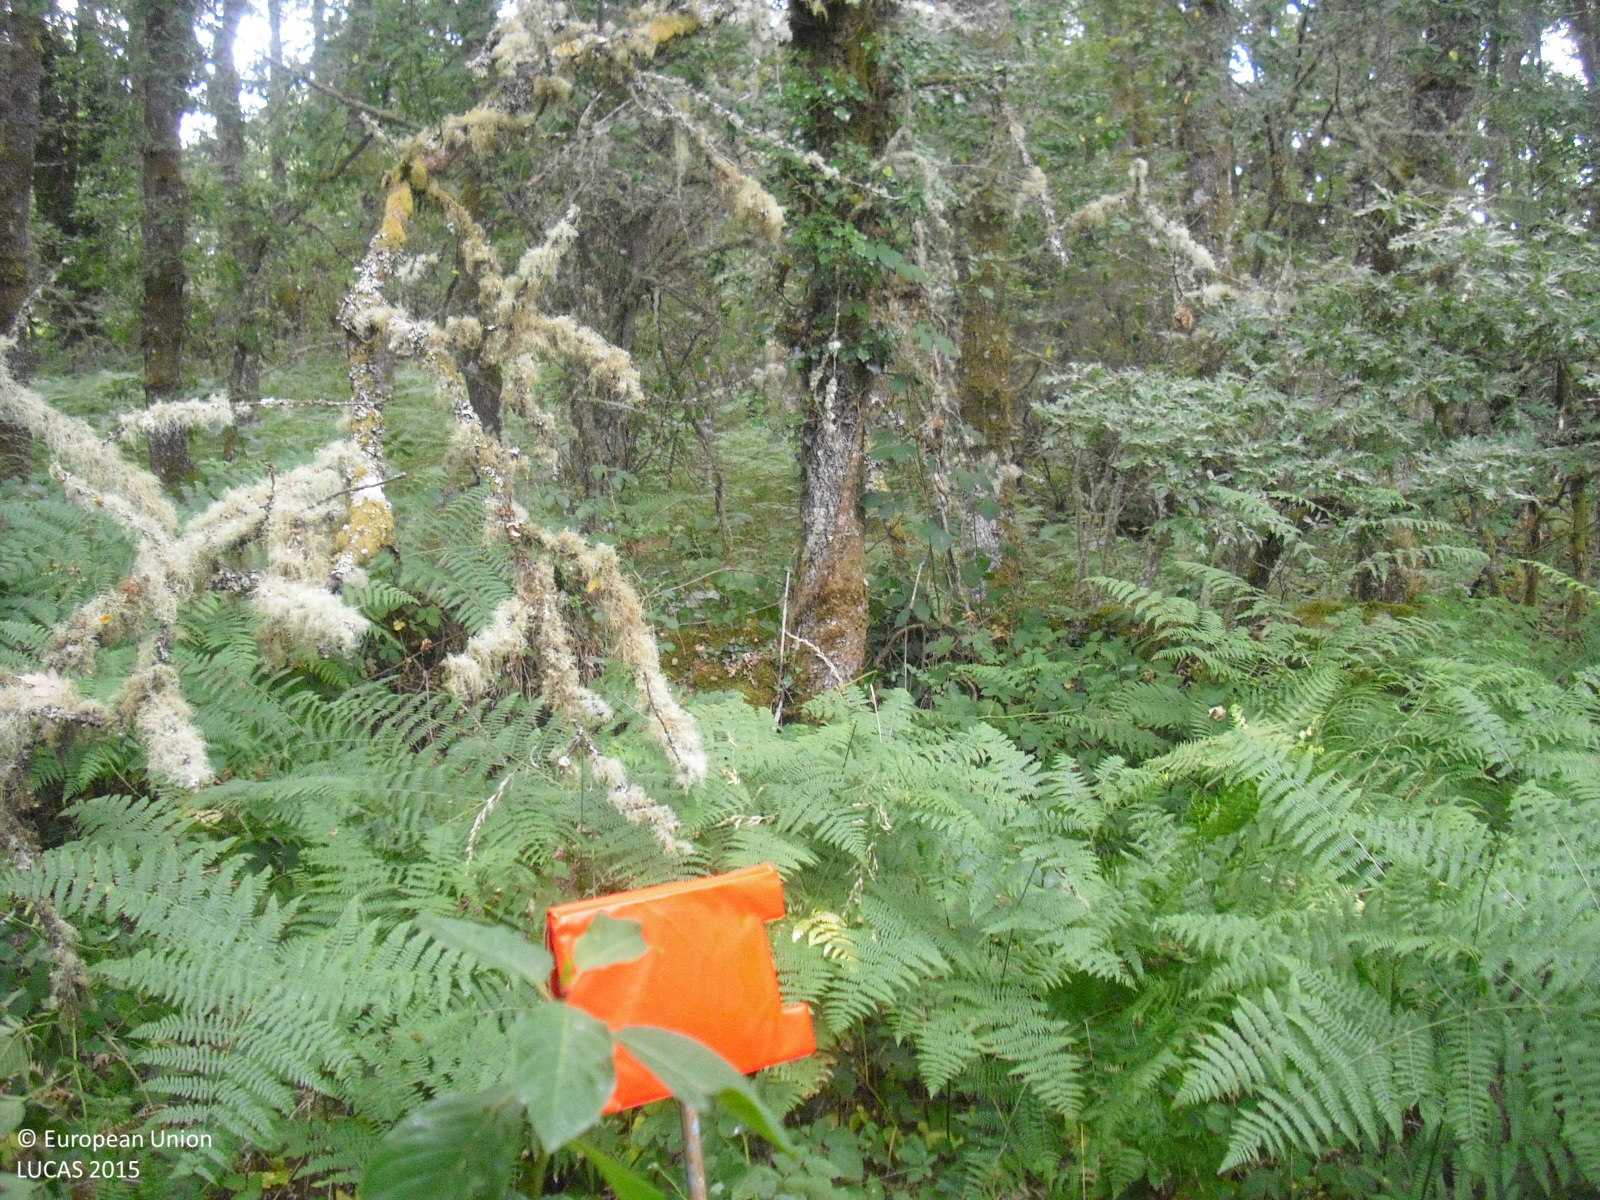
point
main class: Woodland
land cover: Broadleaved woodland
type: thermophilous deciduous forest
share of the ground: 50 - 75 %
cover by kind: broadleaved forest trees 60 %, shrubs 40 %
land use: Forestry
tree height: < 5 m
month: July
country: ES
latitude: 42.3403
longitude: -7.4592
